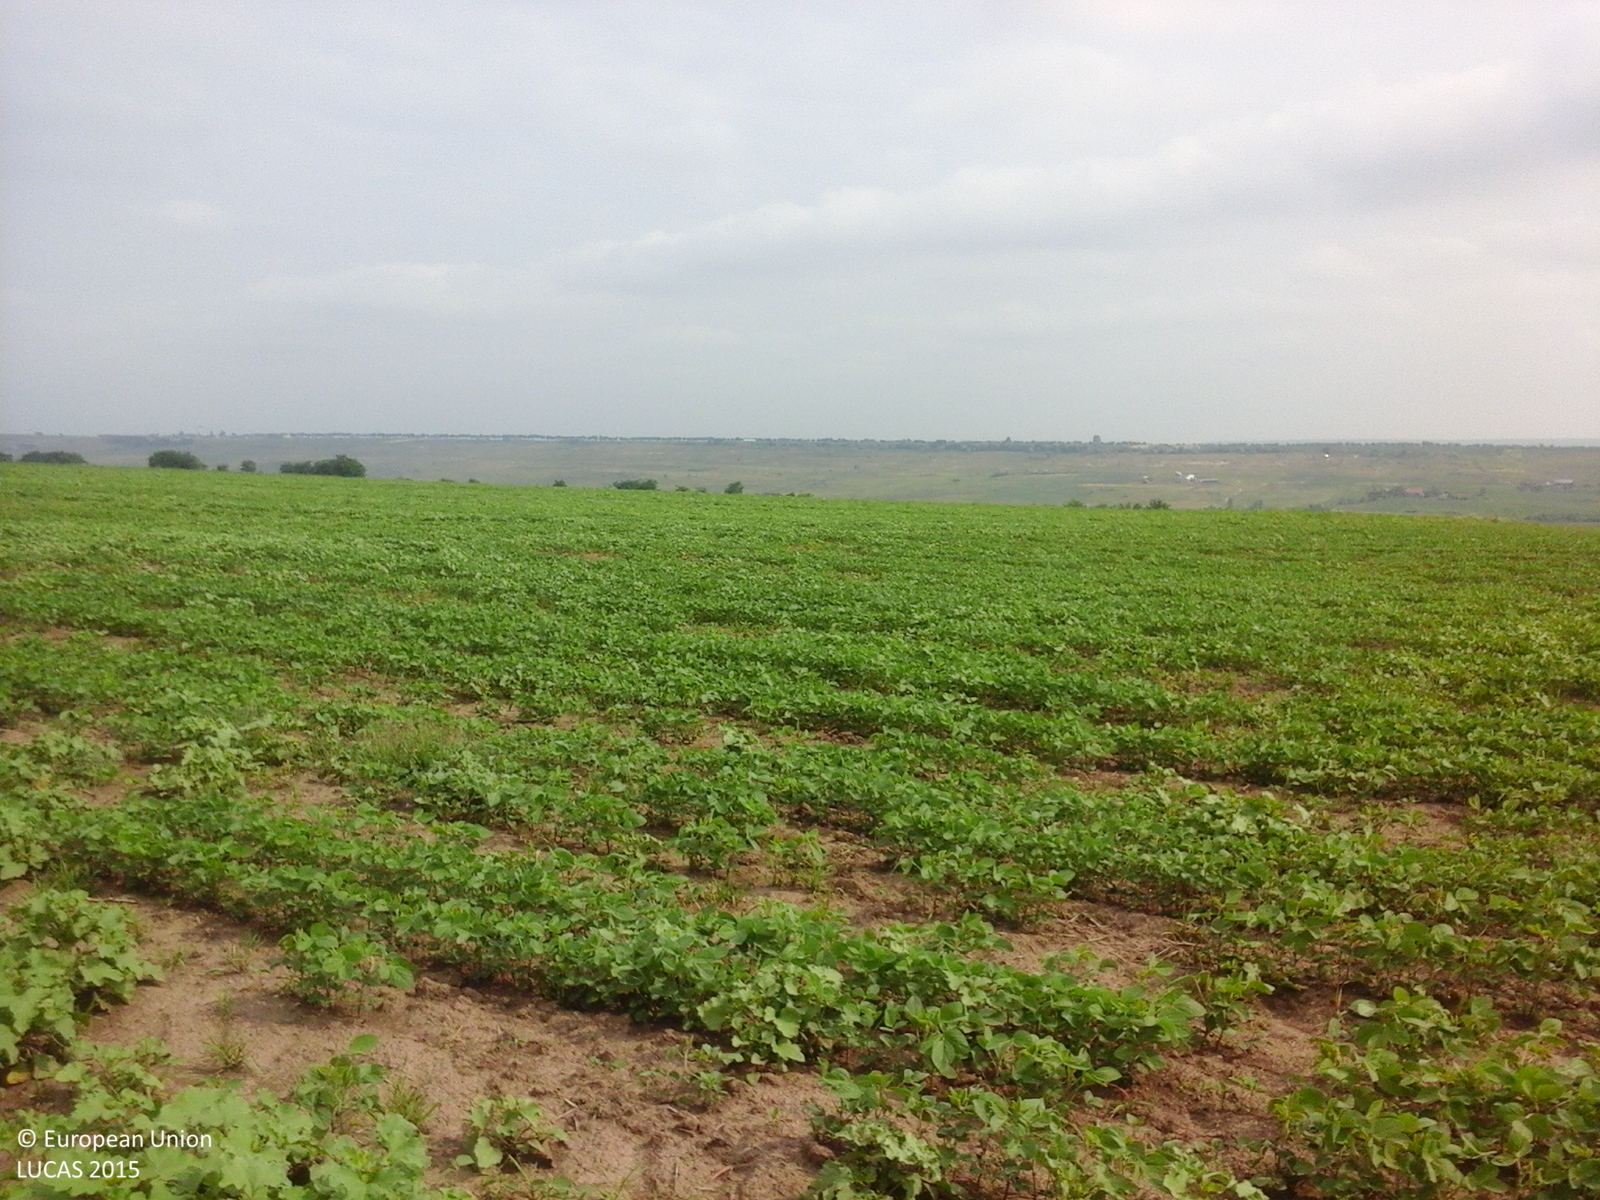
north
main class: Cropland
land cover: Soya
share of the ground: 50 - 75 %
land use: Agriculture (excluding fallow land and kitchen gardens)
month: June
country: RO
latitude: 47.7754
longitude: 26.6287
